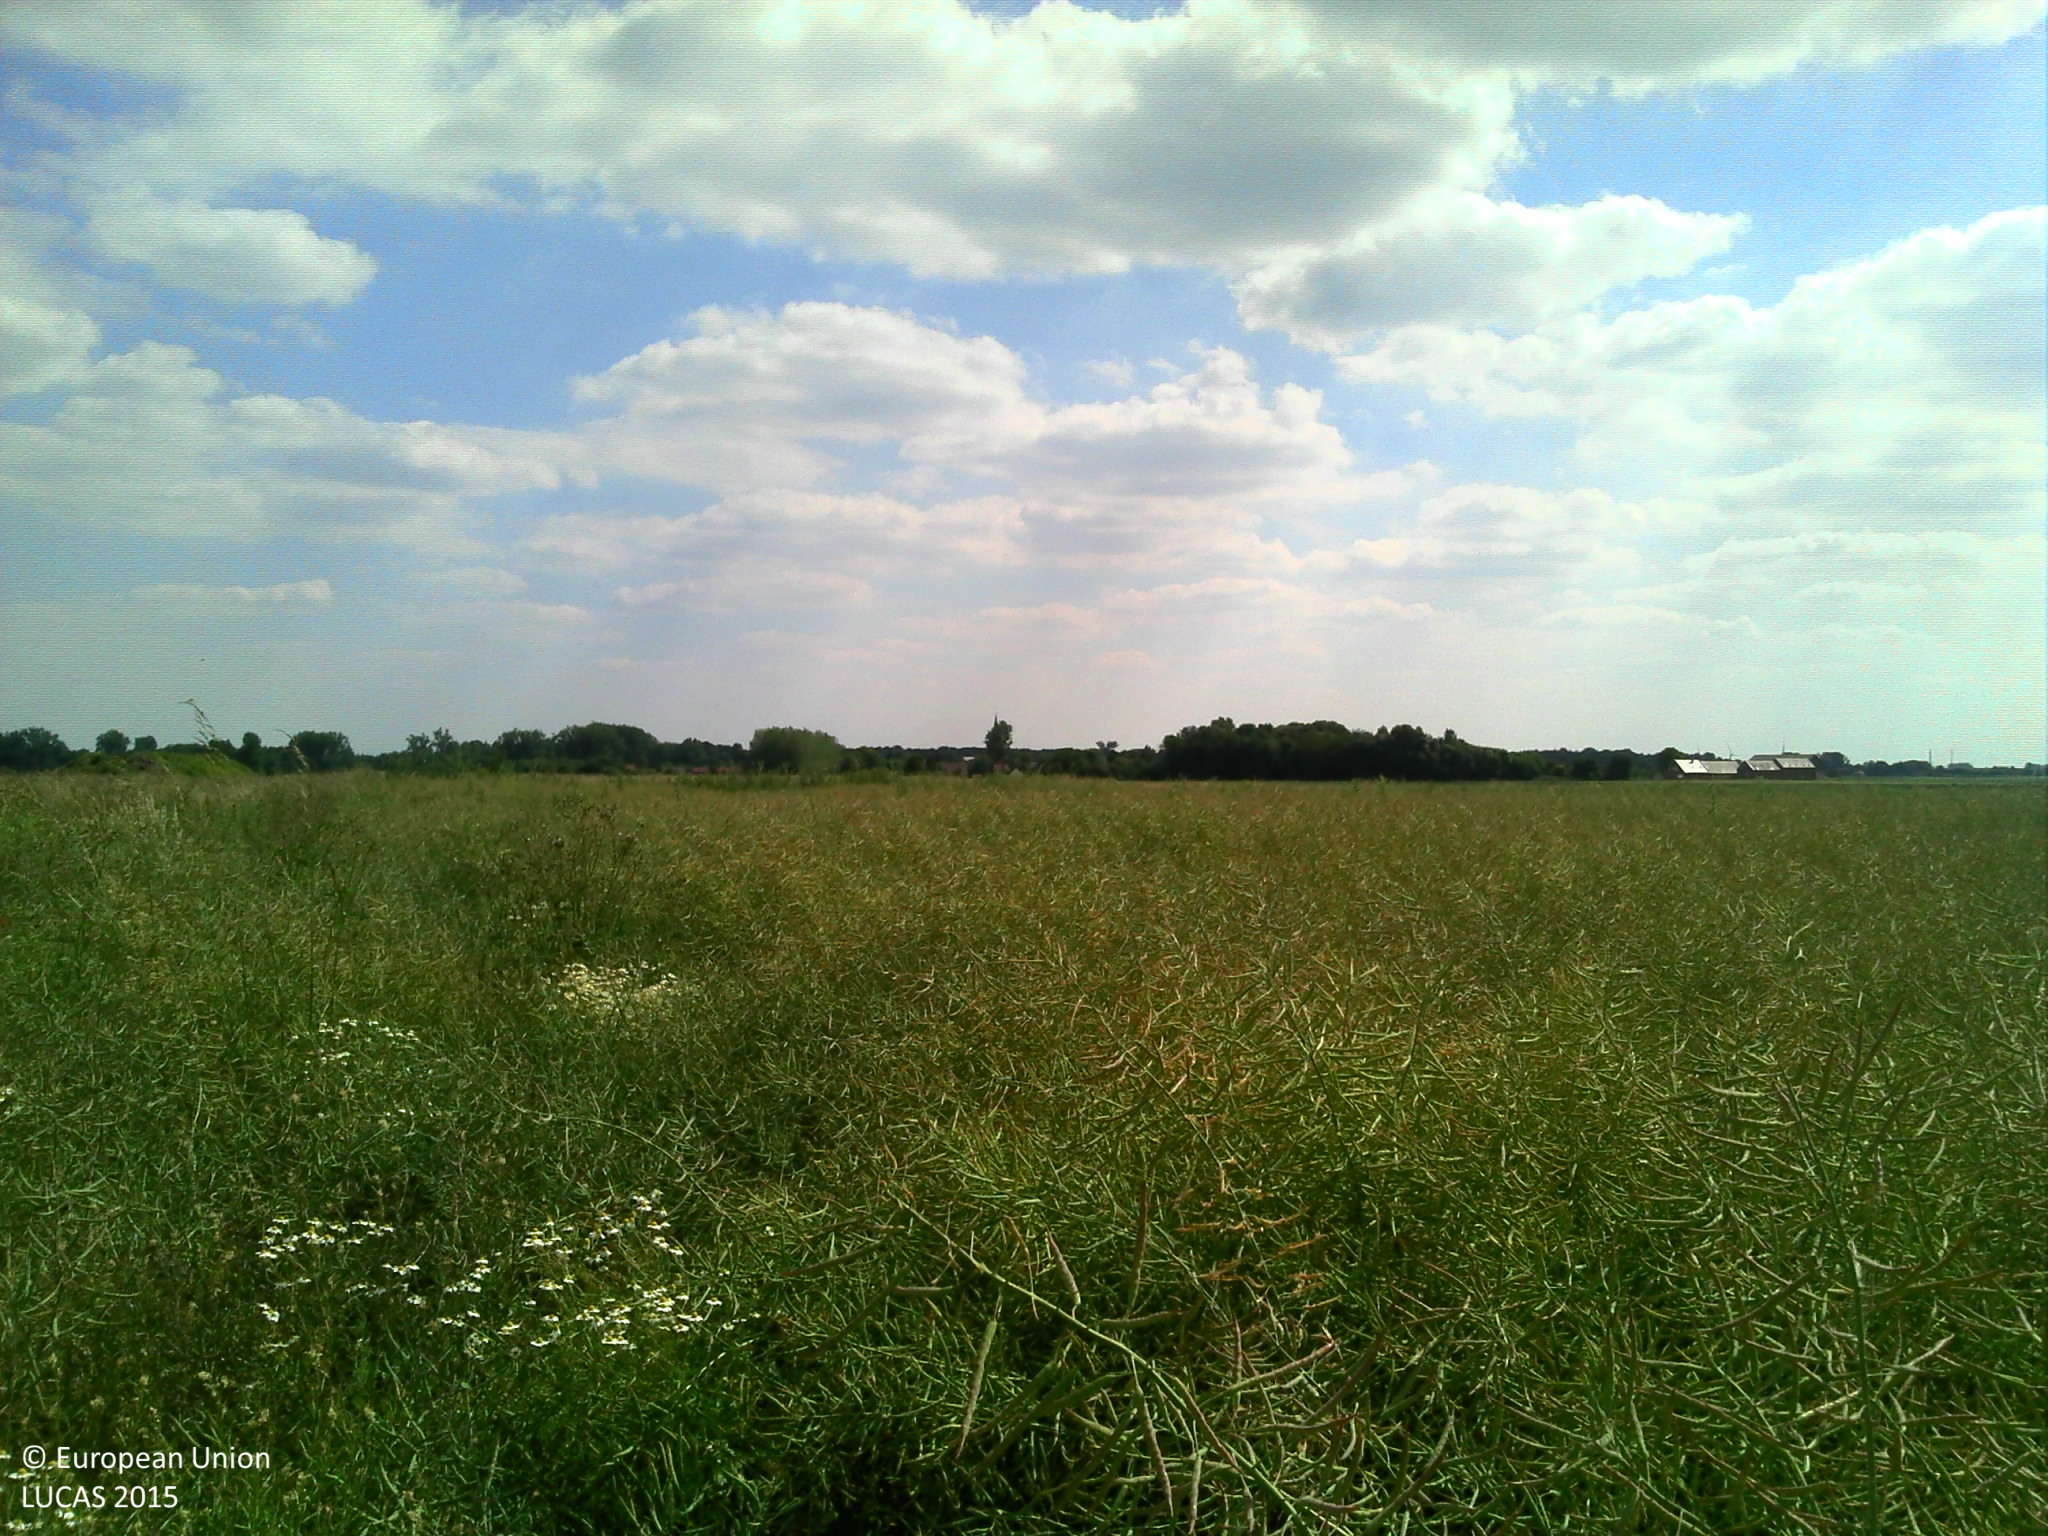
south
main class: Cropland
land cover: Rape and turnip rape
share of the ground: > 75 %
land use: Agriculture (excluding fallow land and kitchen gardens)
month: June
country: FR
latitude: 49.6496
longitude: 2.8011
